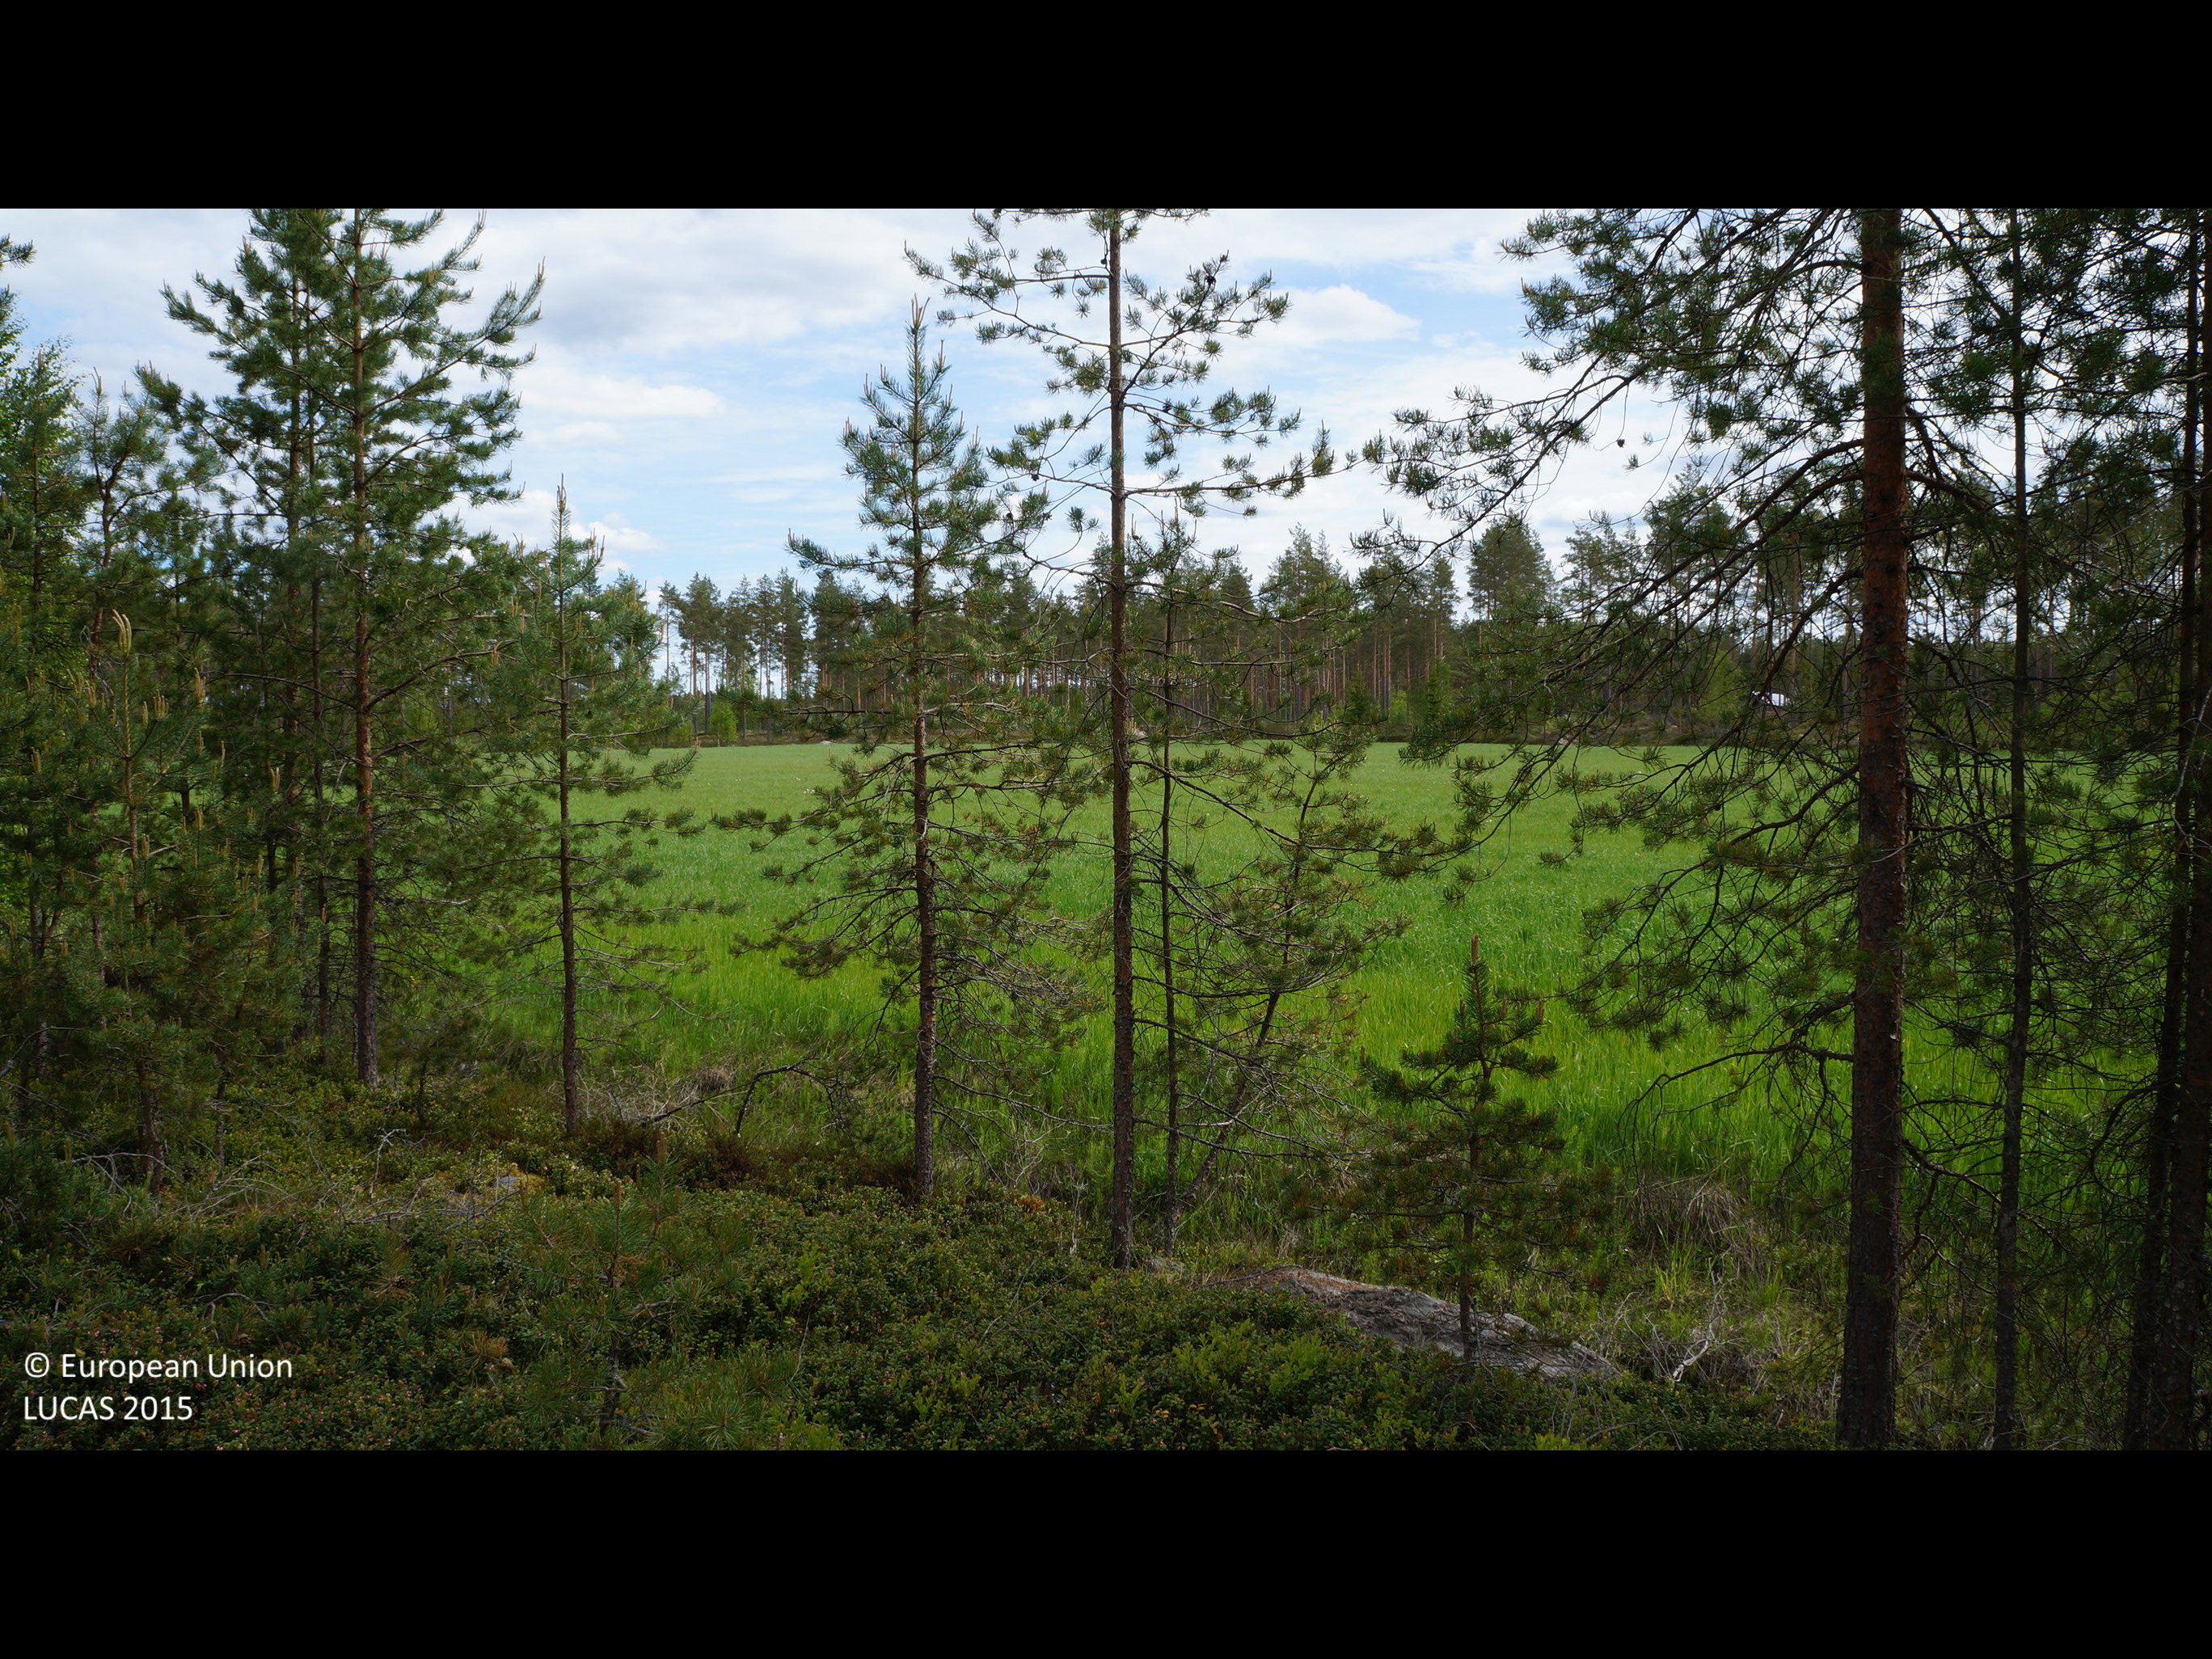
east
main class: Woodland
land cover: Pine dominated coniferous woodland
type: boreal forest
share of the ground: 50 - 75 %
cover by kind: coniferous forest trees 70 %, herbaceous plants 15 %, shrubs 10 %, lichens and mosses 5 %
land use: Forestry
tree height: > 5 m
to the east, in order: Pine dominated coniferous woodland; Ditches and canals; Temporary grasslands; Pine dominated coniferous woodland; Tracks; Pine dominated coniferous woodland; Broadleaved woodland; Pine dominated coniferous woodland; Tracks
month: June
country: FI
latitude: 63.9707
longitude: 23.4343
